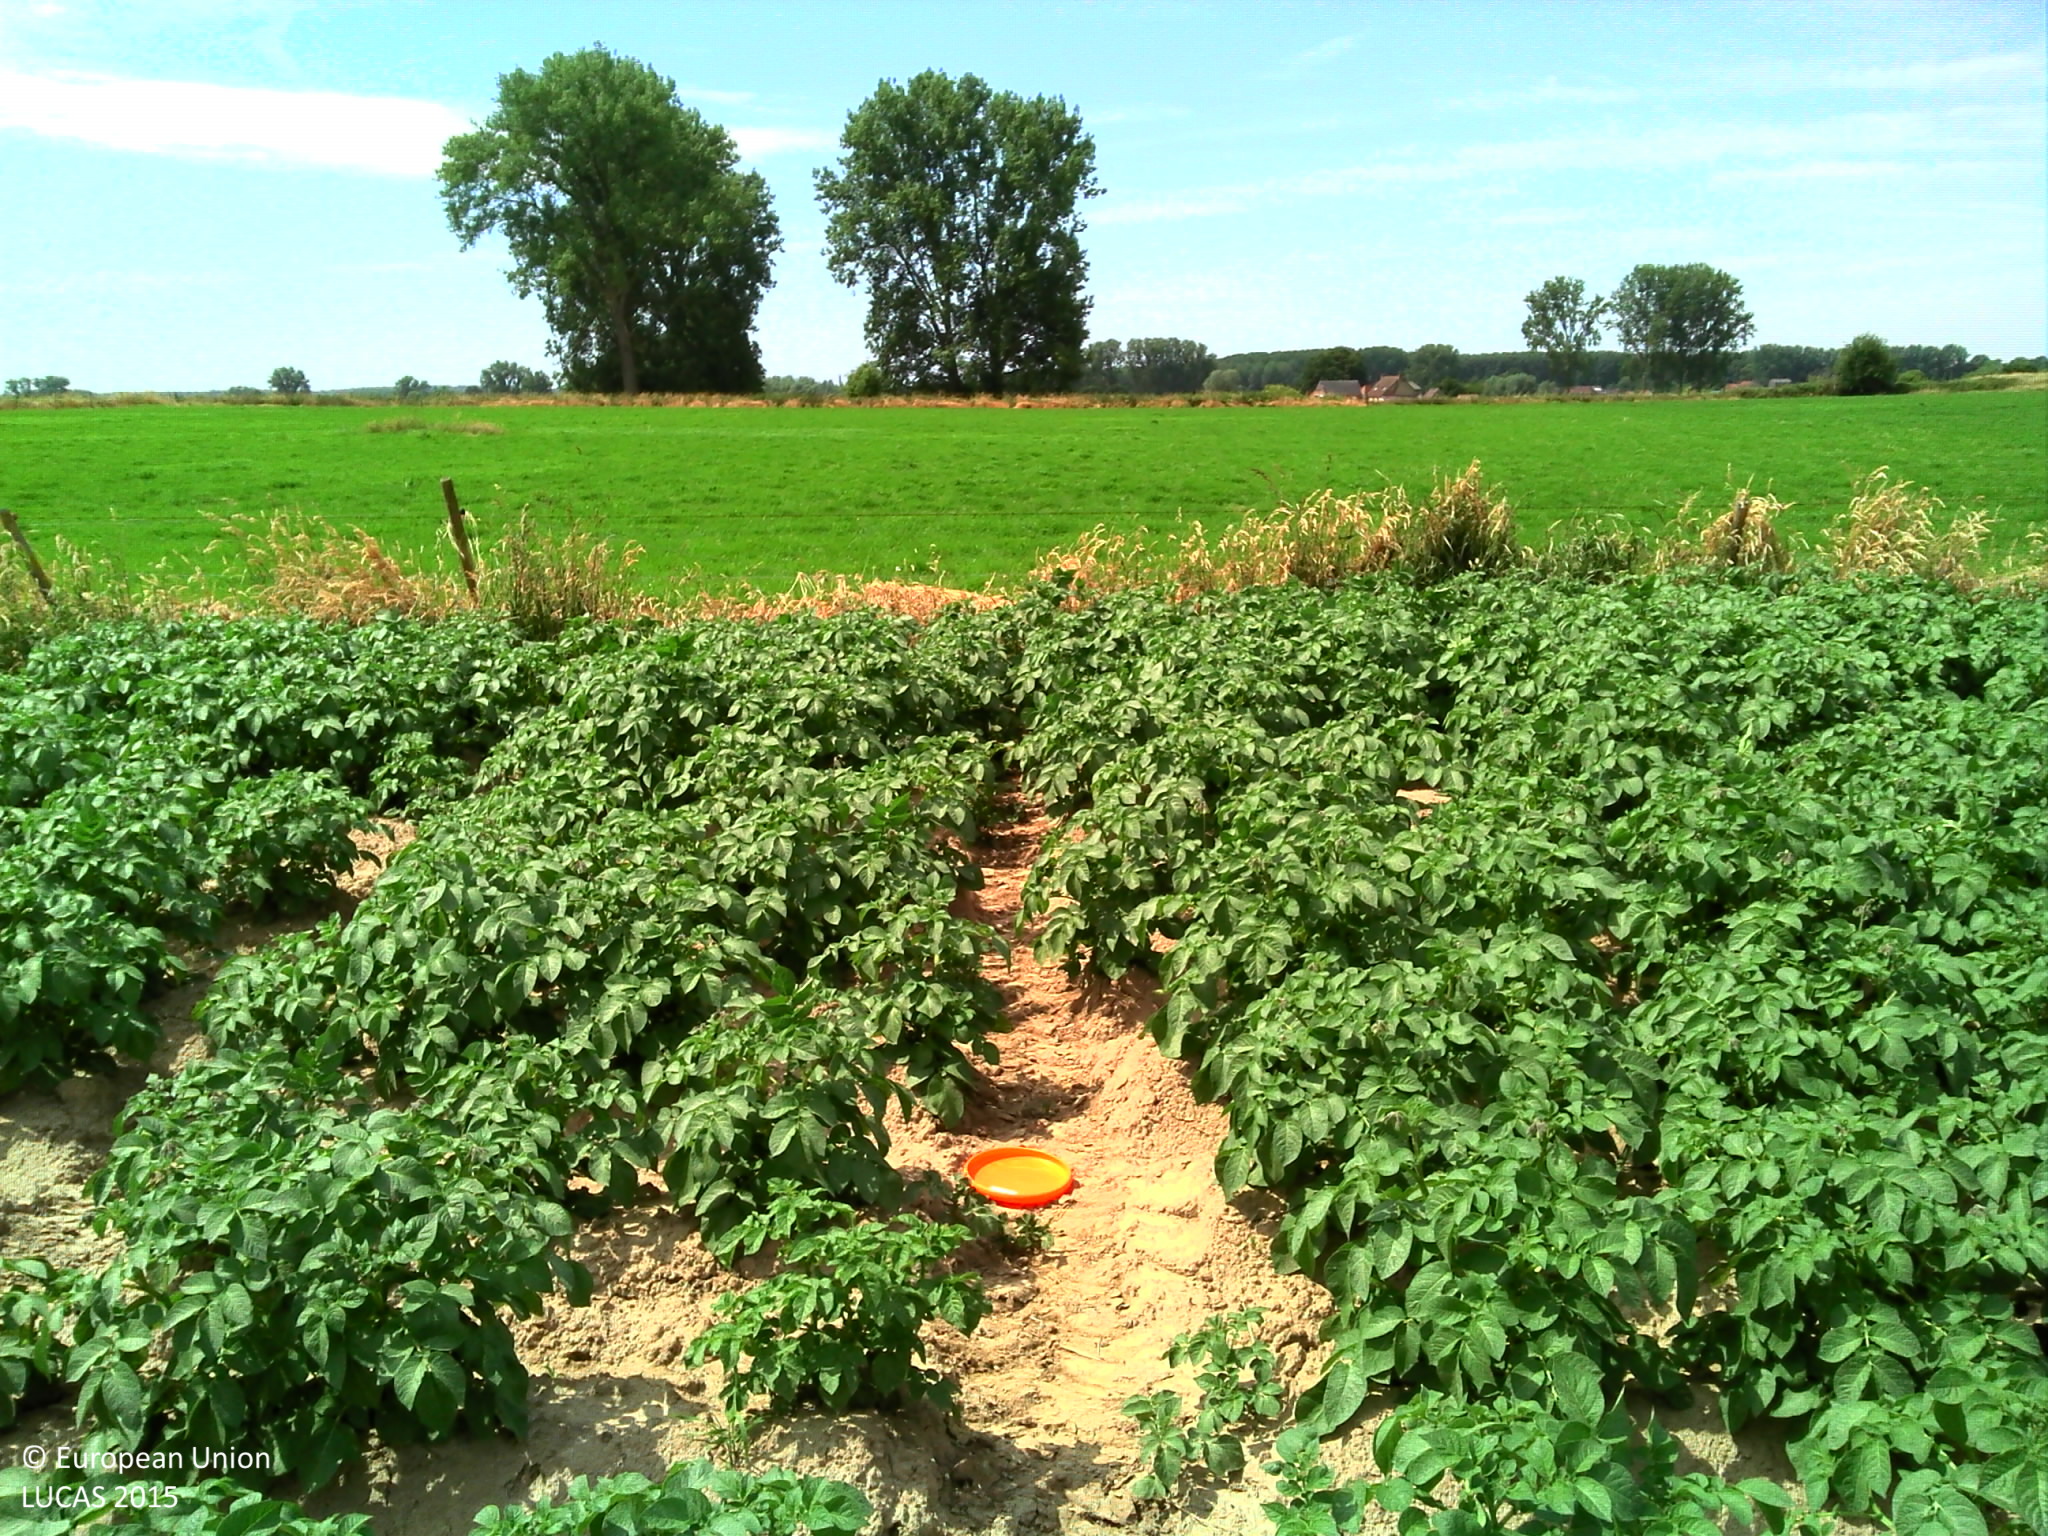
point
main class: Cropland
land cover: Potatoes
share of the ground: 50 - 75 %
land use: Agriculture (excluding fallow land and kitchen gardens)
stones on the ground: < 10 %
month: June
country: BE
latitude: 50.5487
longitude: 3.6562
